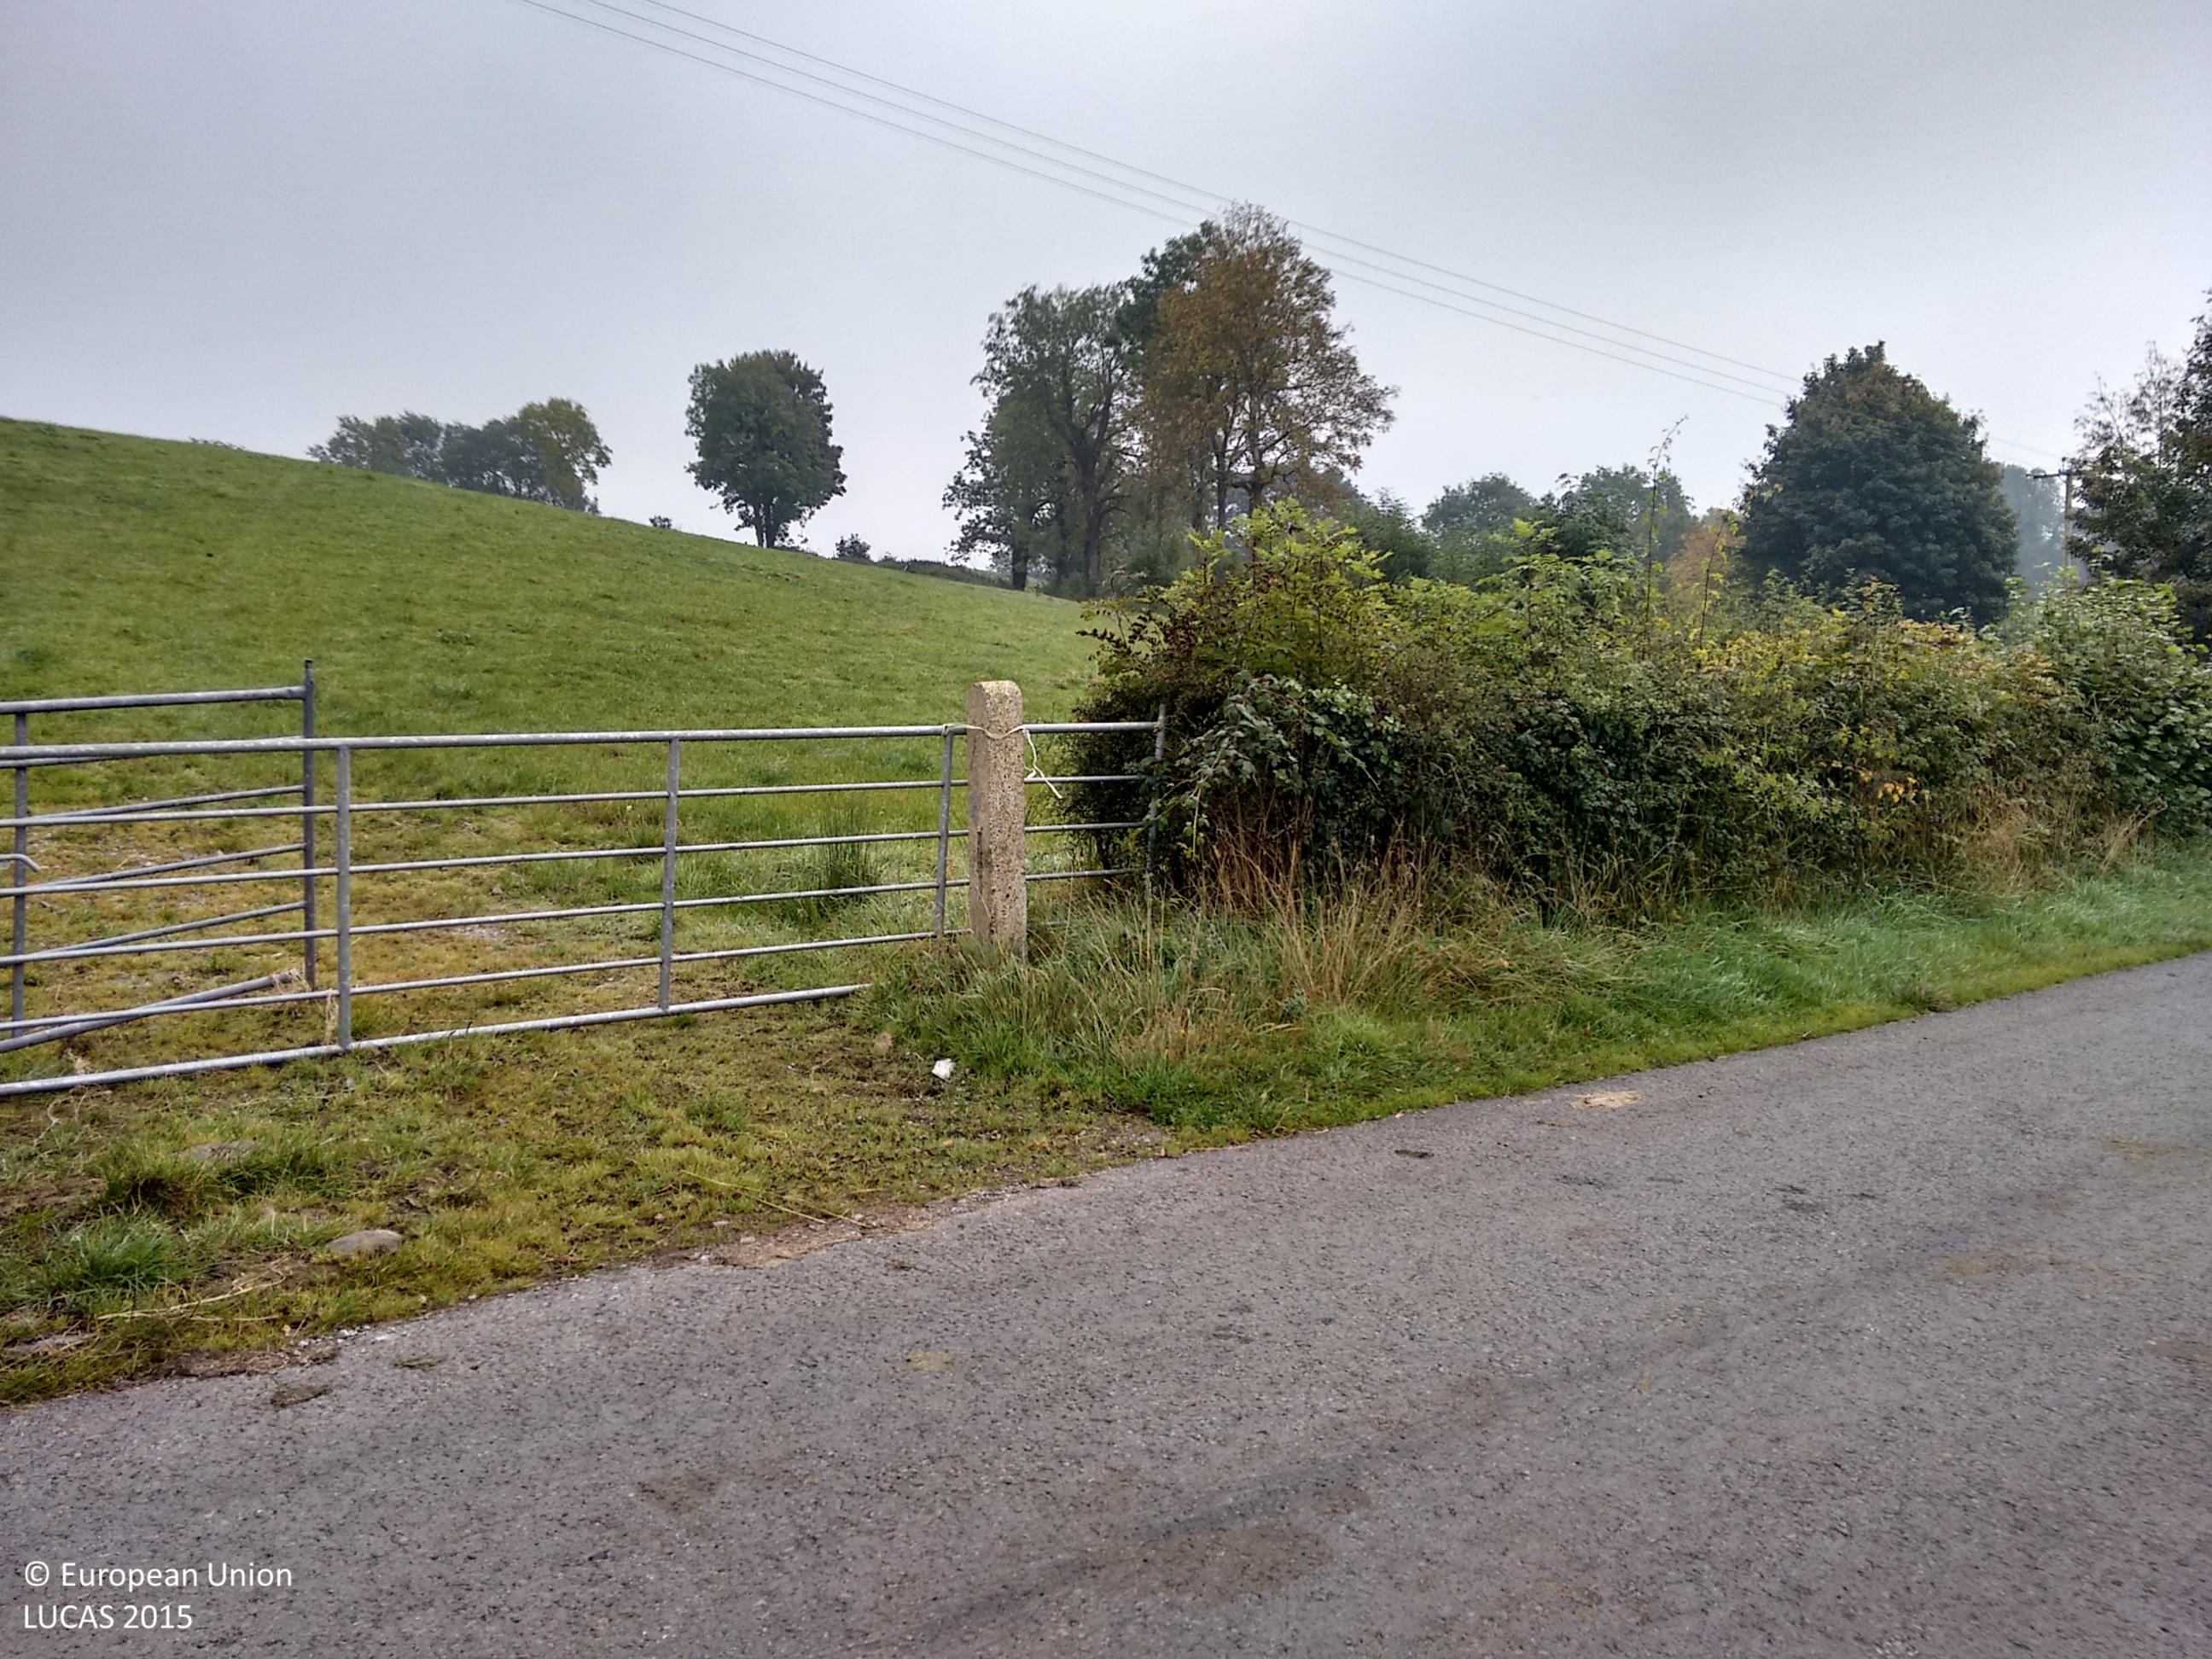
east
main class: Grassland
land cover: Grassland without tree/shrub cover
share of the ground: > 75 %
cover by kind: herbaceous plants 100 %
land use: Agriculture (excluding fallow land and kitchen gardens)
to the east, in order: Grassland without tree/shrub cover; Electric lines; Grassland without tree/shrub cover; Managed hedges; Grass margins; Electric lines; Paved roads, cycling and walking lanes; Grass margins; Managed hedges; Grassland without tree/shrub cover; Electric lines; Grassland without tree/shrub cover; Managed hedges; Grassland without tree/shrub cover
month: October
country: GB
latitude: 54.4438
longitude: -7.8231
